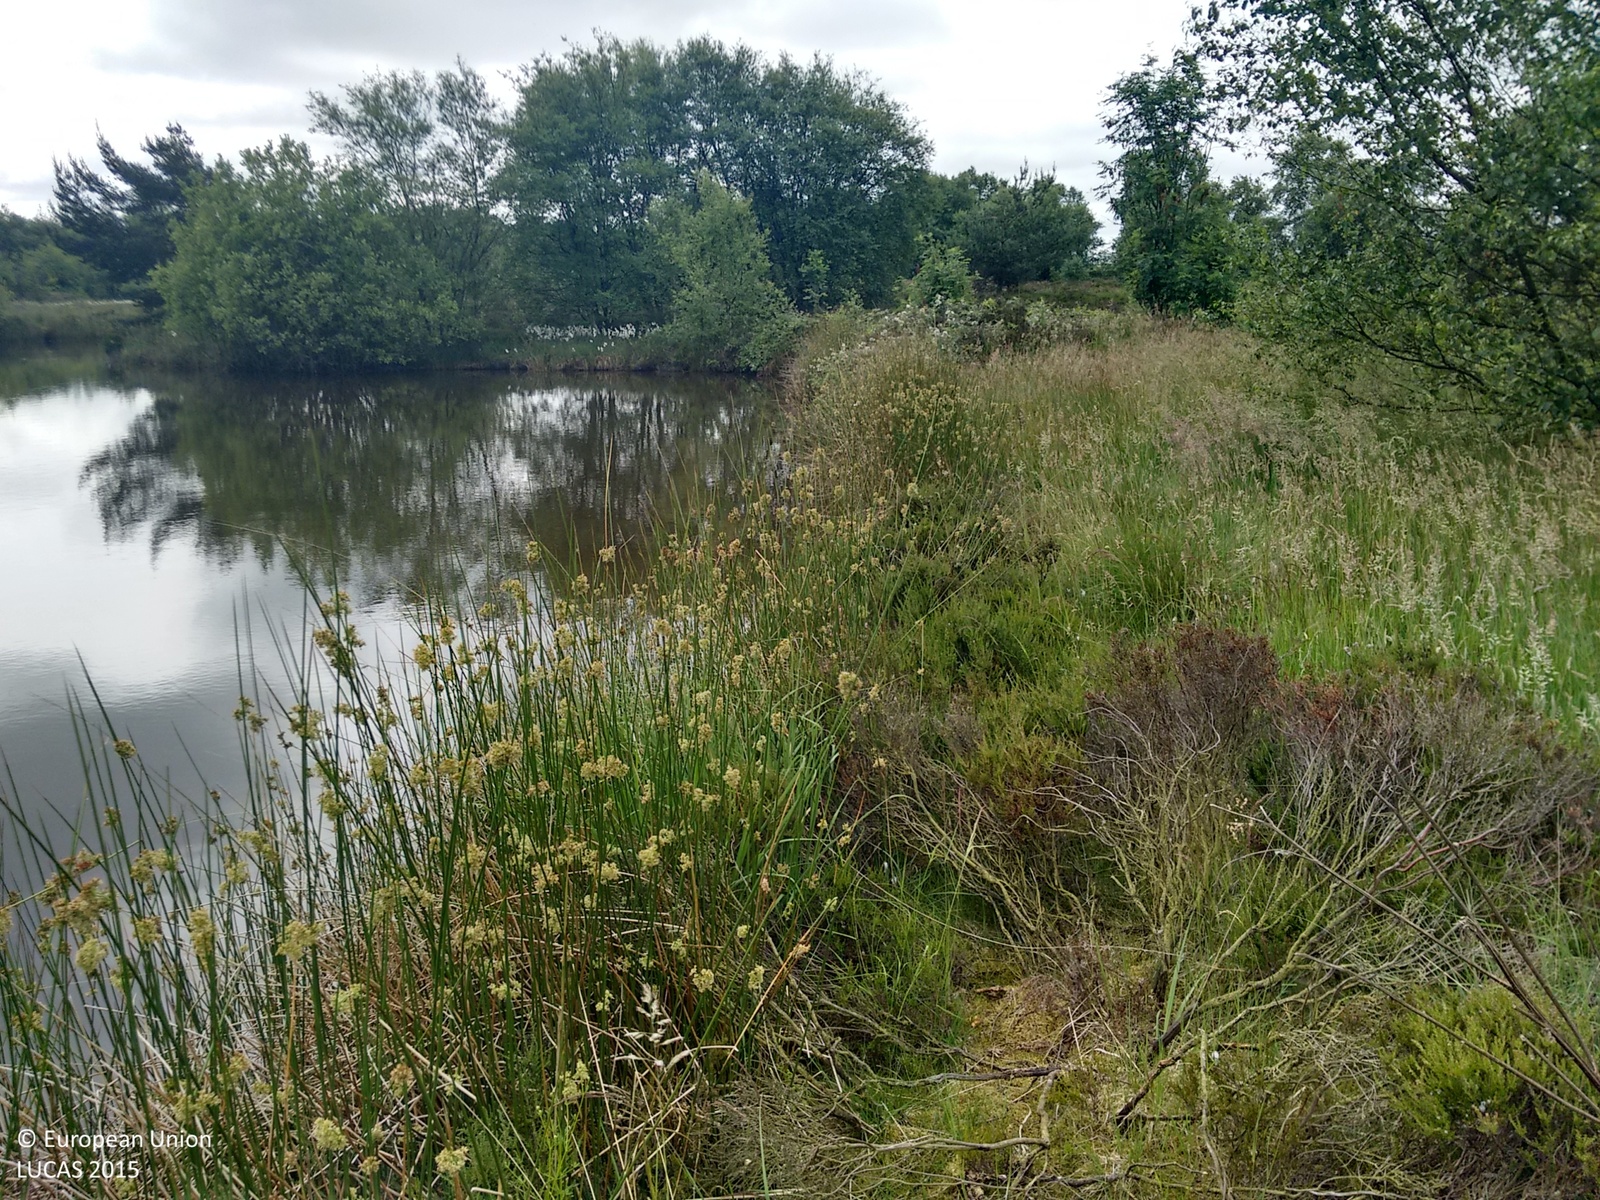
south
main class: Shrubland
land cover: Shrubland with sparse tree cover
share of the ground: > 75 %
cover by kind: shrubs 95 %, broadleaved forest trees 5 %
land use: Semi-natural and natural areas not in use
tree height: > 5 m
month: July
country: GB
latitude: 53.1970
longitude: -1.5016
